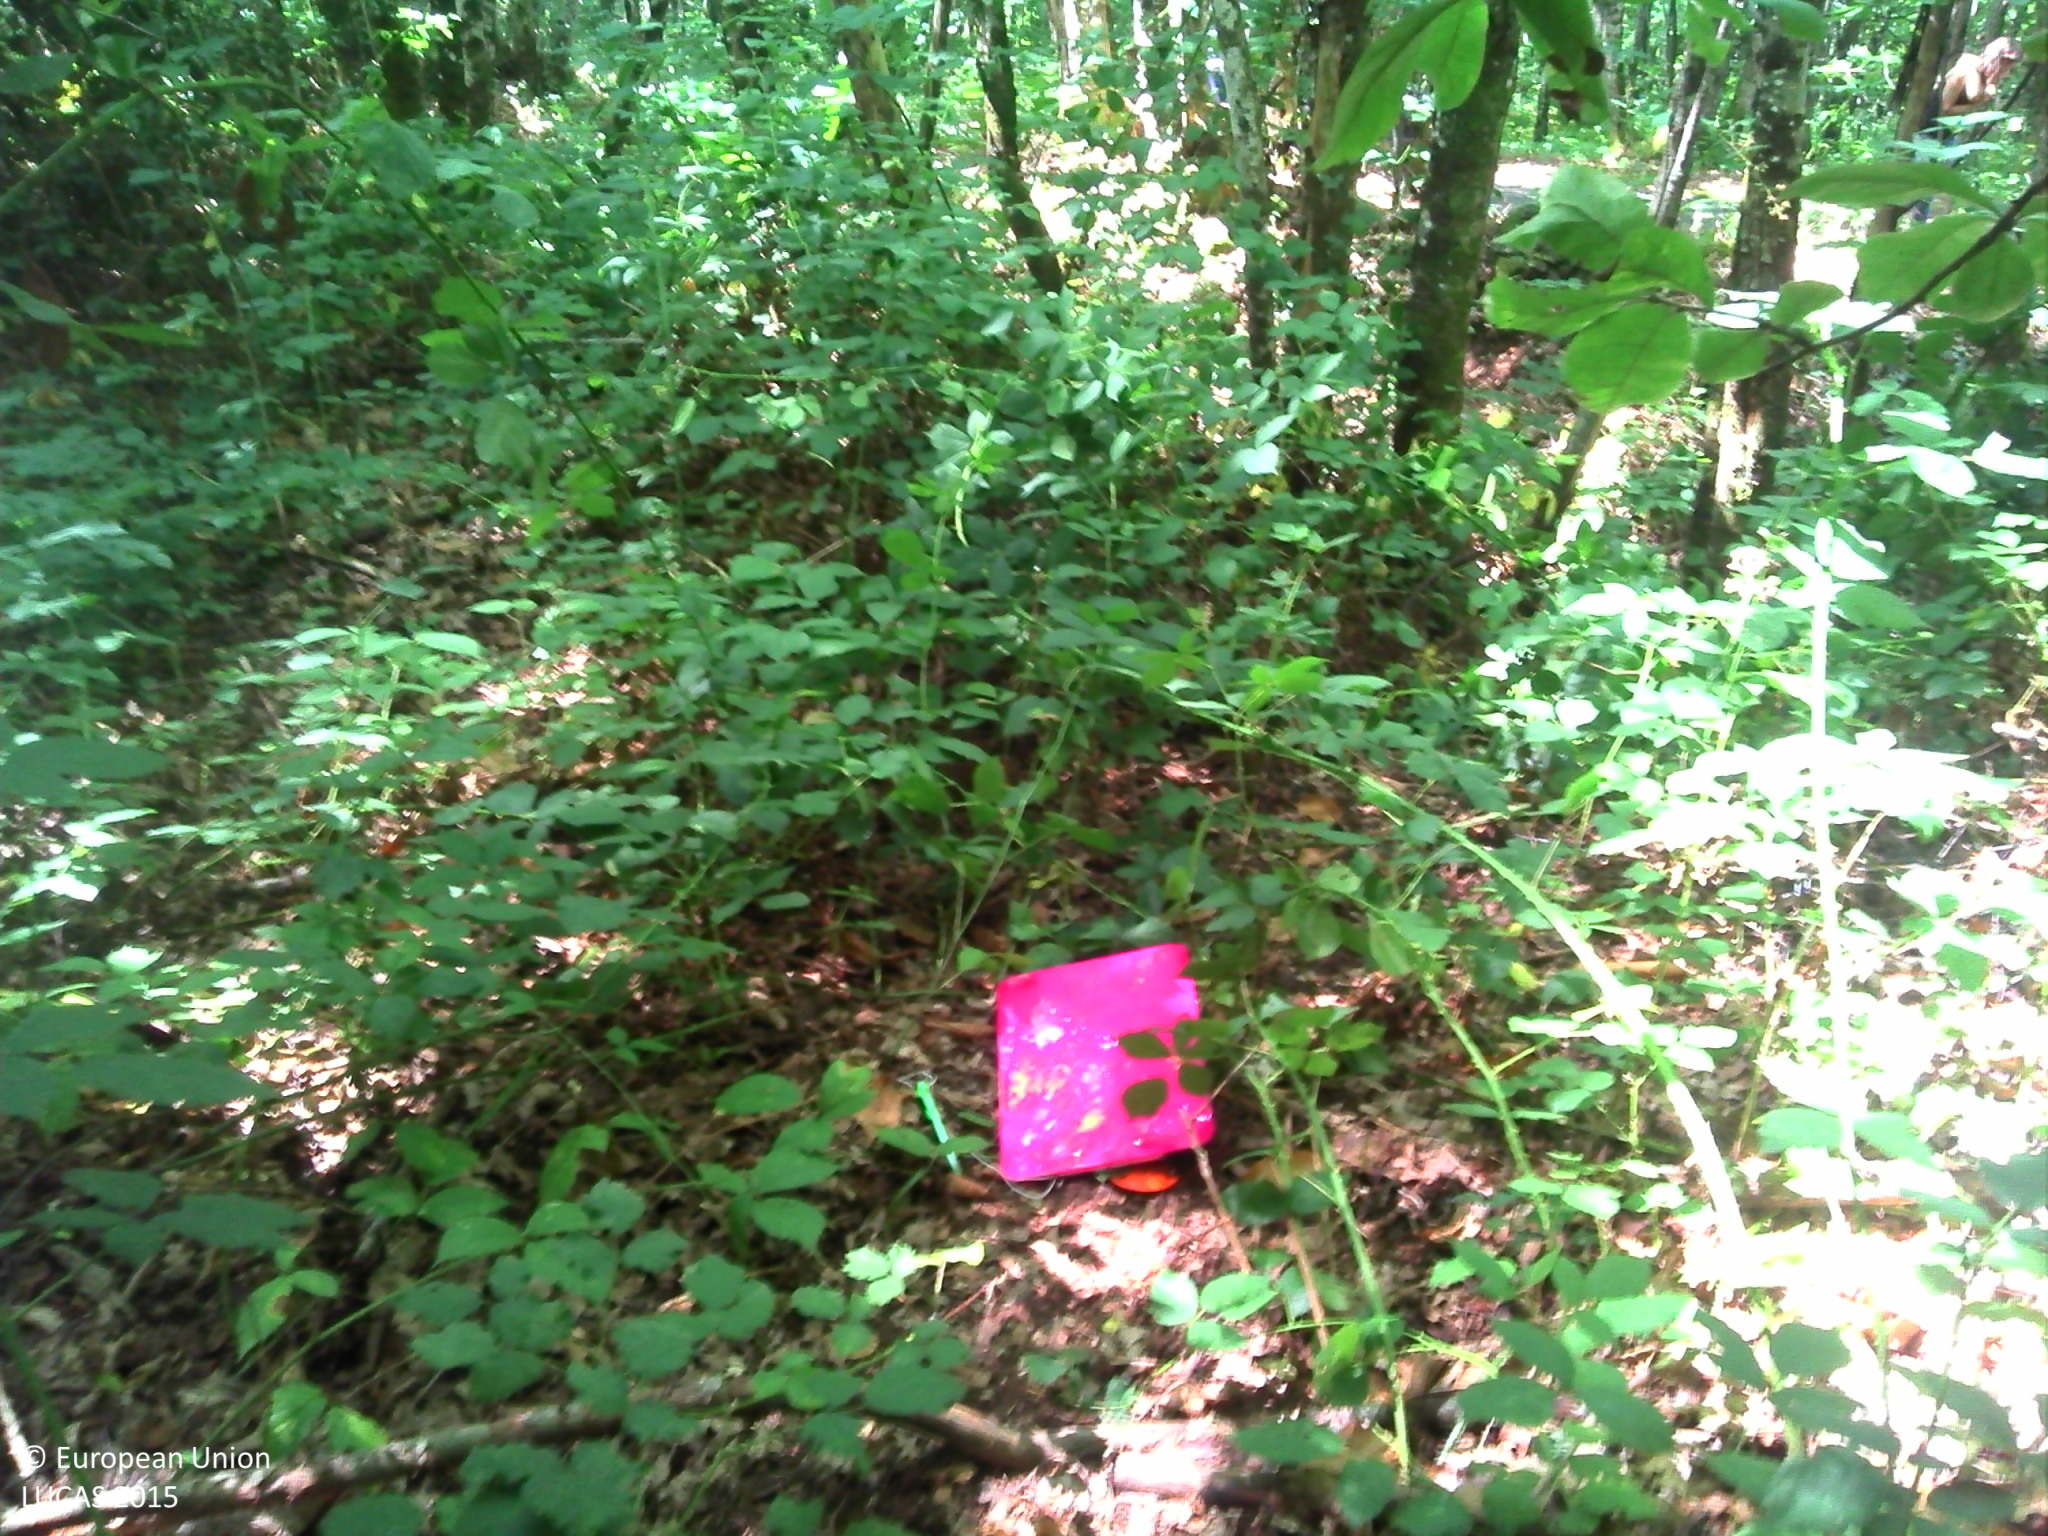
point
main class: Woodland
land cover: Broadleaved woodland
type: mesophytic deciduous forest
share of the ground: > 75 %
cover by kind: broadleaved forest trees 70 %, herbaceous plants 20 %, coniferous forest trees 10 %
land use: Abandoned areas
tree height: > 5 m
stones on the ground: < 10 %
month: August
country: FR
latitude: 46.0614
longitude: 1.2123
